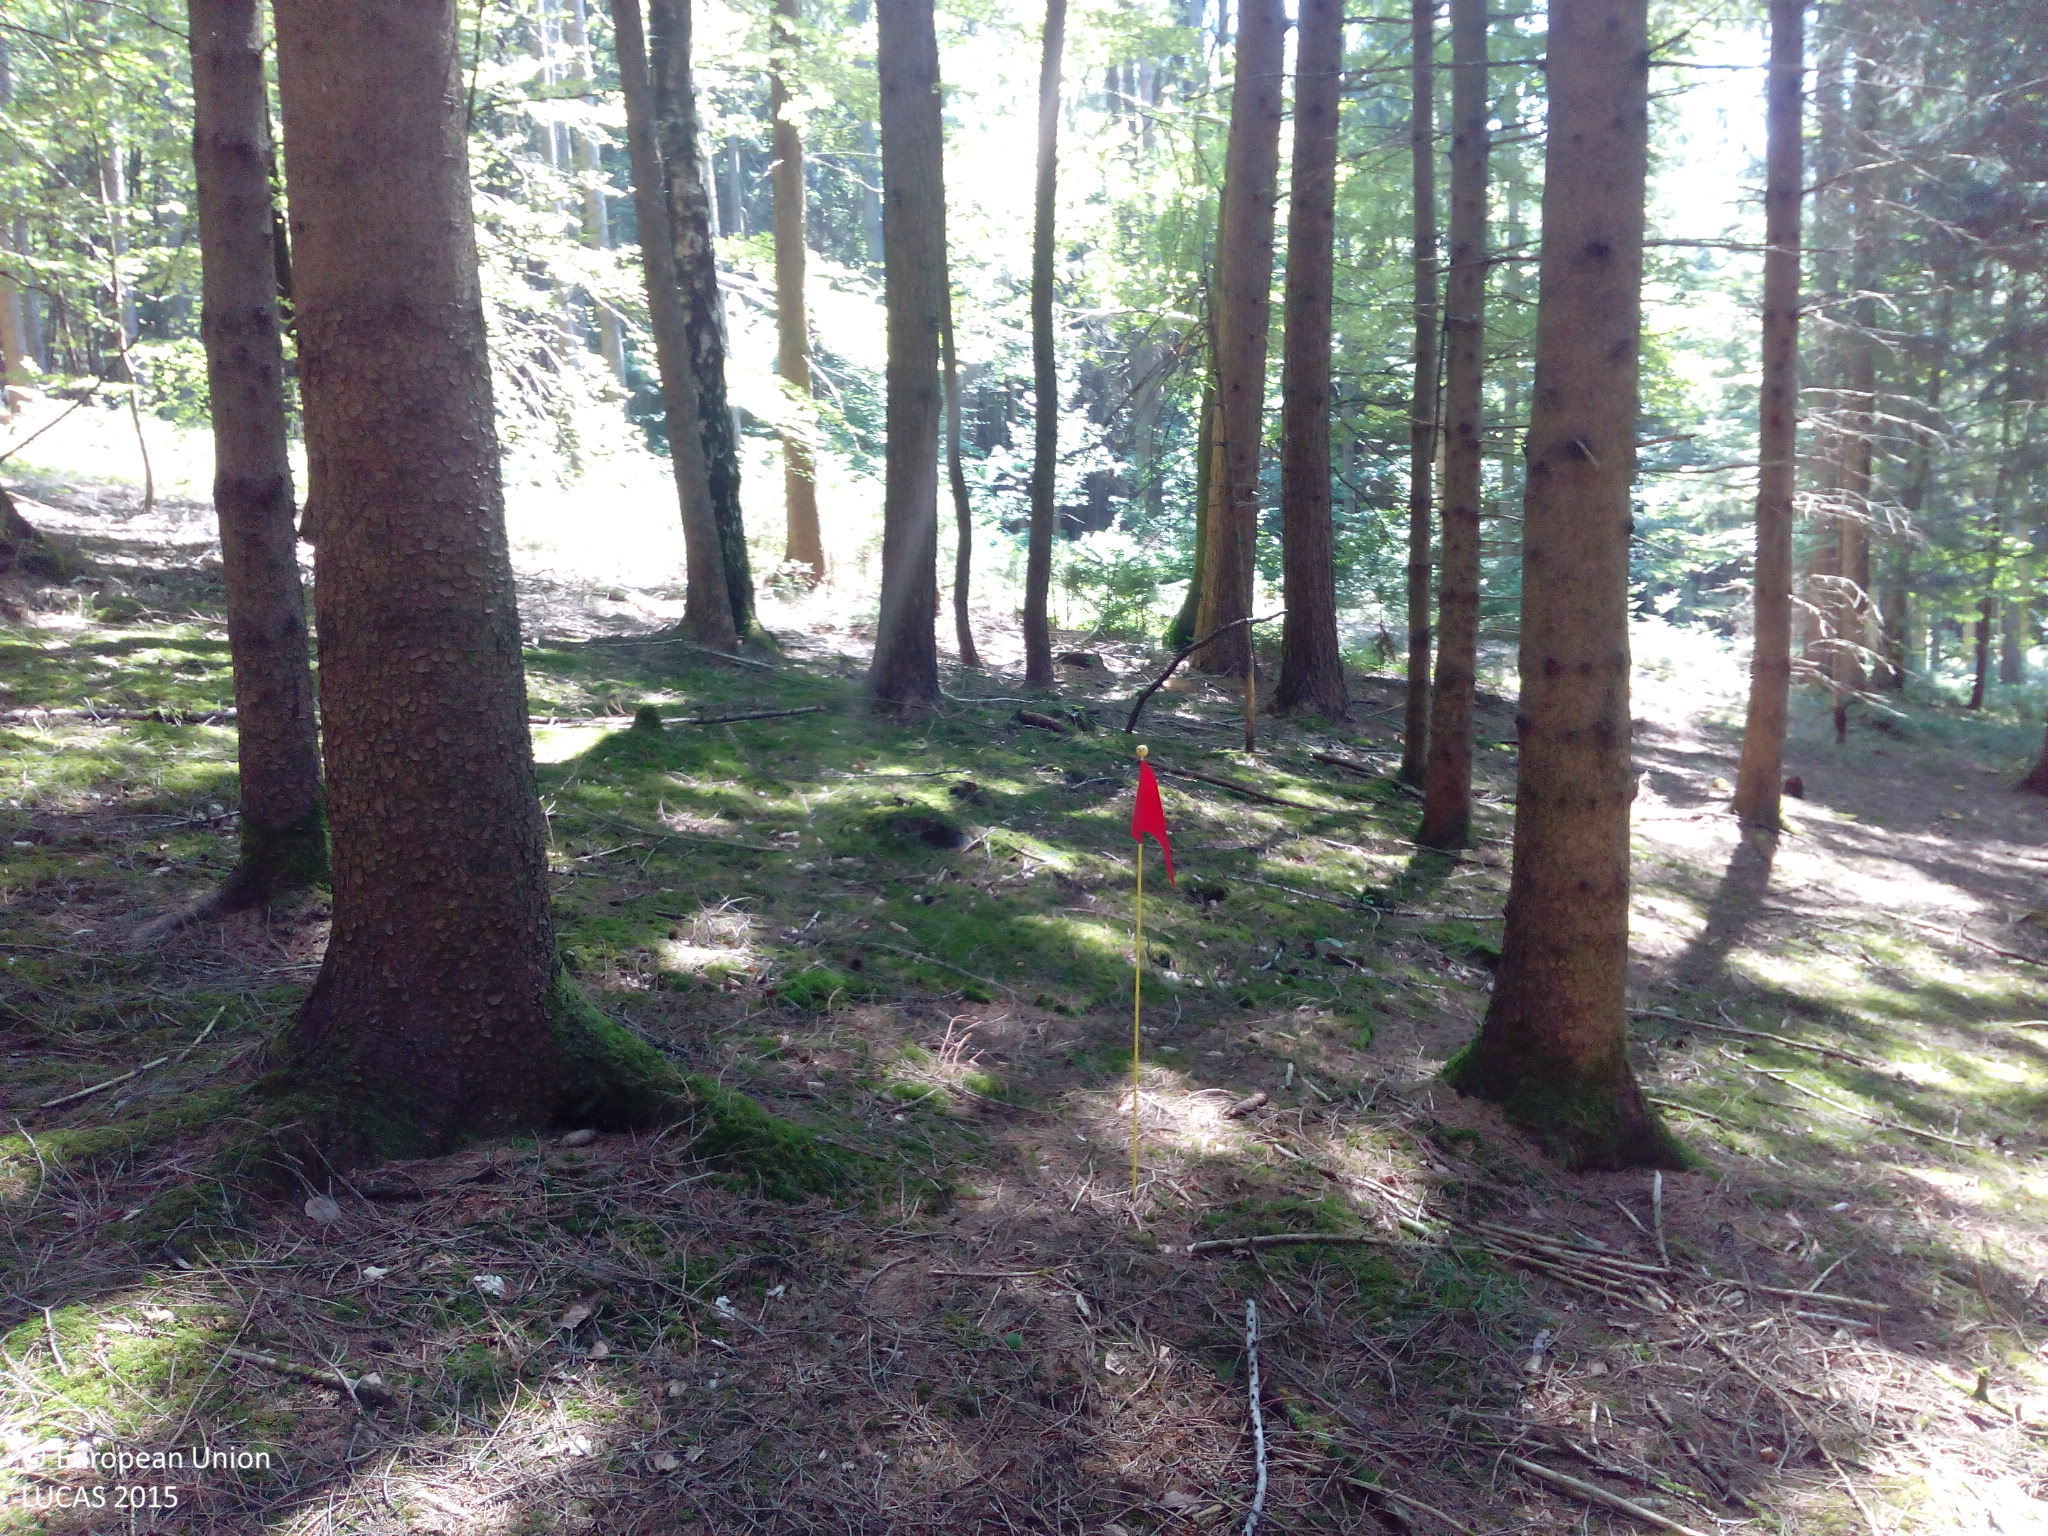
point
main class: Woodland
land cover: Spruce dominated coniferous woodland
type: hemiboreal forest and nemoral coniferous forest and mixed broadleaved-coniferous forest
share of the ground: > 75 %
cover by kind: coniferous forest trees 90 %, broadleaved forest trees 5 %, unconsolidated bare surface 5 %
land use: Forestry
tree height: > 5 m
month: August
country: DE
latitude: 47.9540
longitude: 12.7974
